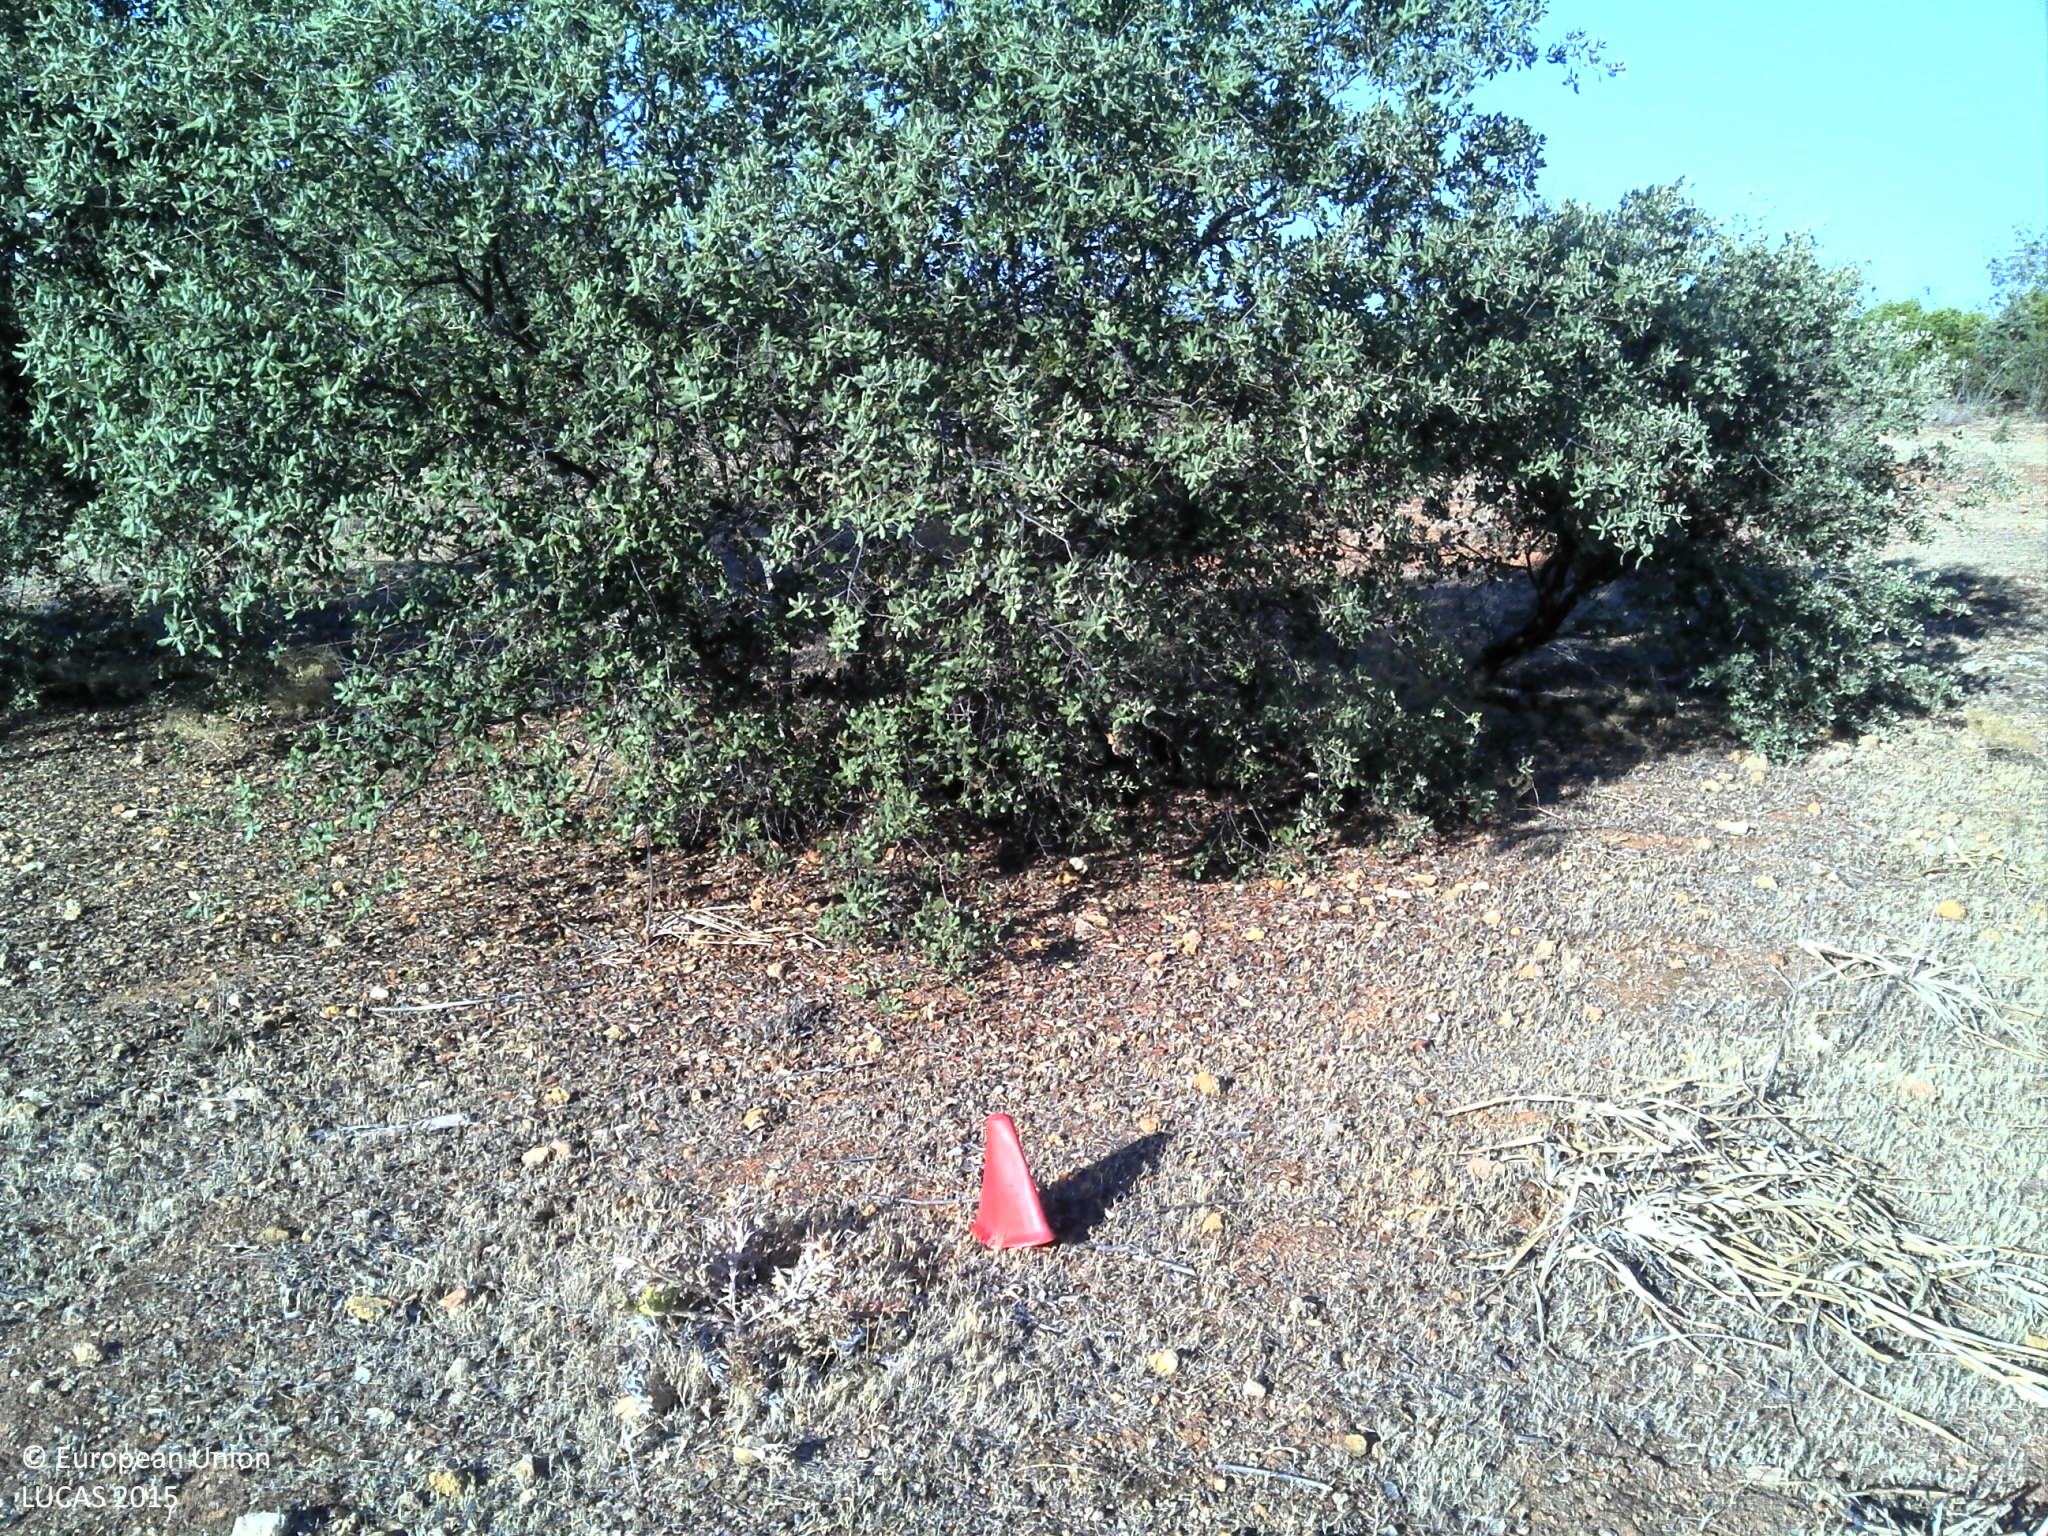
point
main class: Woodland
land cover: Broadleaved woodland
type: broadleaved evergreen forest
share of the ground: 10 - 25 %
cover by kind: unconsolidated bare surface 50 %, broadleaved forest trees 25 %, herbaceous plants 25 %
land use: Forestry
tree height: < 5 m
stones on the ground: < 10 %
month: June
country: PT
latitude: 37.0736
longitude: -7.7895
